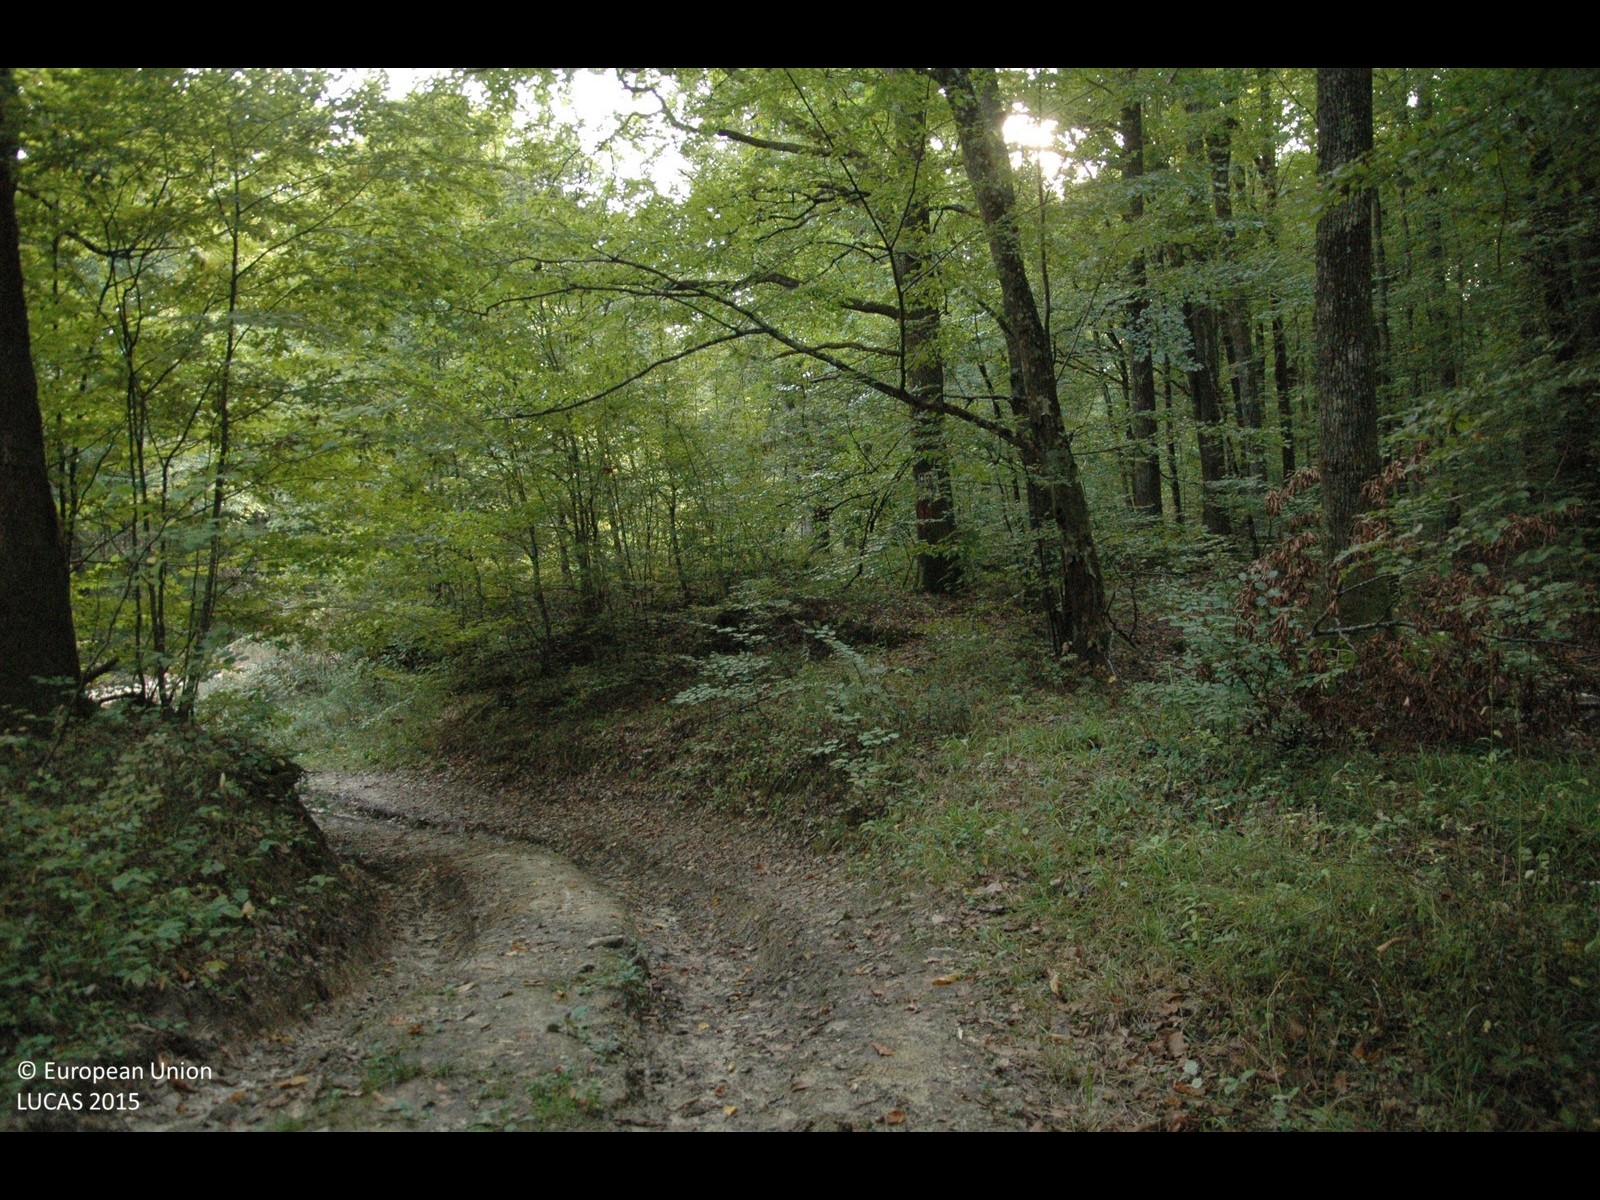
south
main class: Woodland
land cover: Broadleaved woodland
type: mesophytic deciduous forest
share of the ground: > 75 %
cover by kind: broadleaved forest trees 100 %
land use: Forestry
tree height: > 5 m
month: October
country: HR
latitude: 45.5385
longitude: 16.2087
